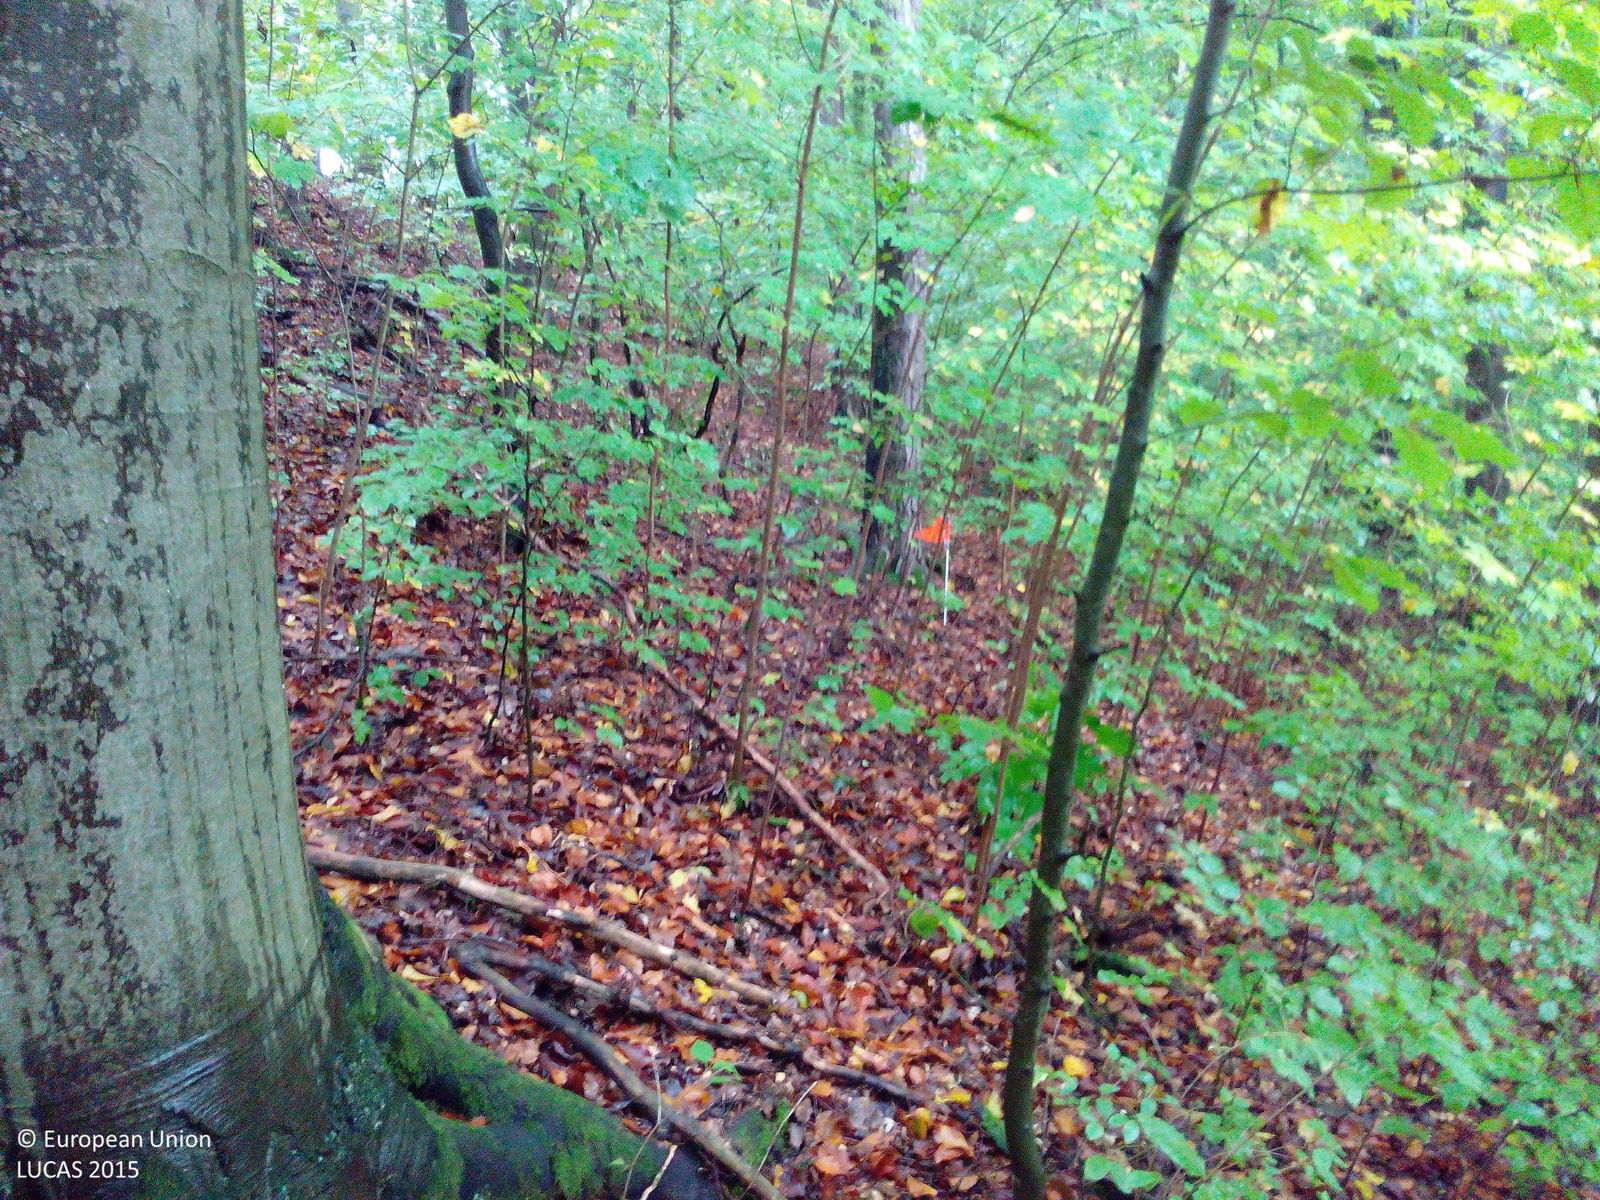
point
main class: Woodland
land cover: Broadleaved woodland
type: beech forest
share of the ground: 50 - 75 %
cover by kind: broadleaved forest trees 70 %, unconsolidated bare surface 15 %, shrubs 10 %, herbaceous plants 5 %
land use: Forestry
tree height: > 5 m
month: October
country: DE
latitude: 50.0943
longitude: 9.9022
